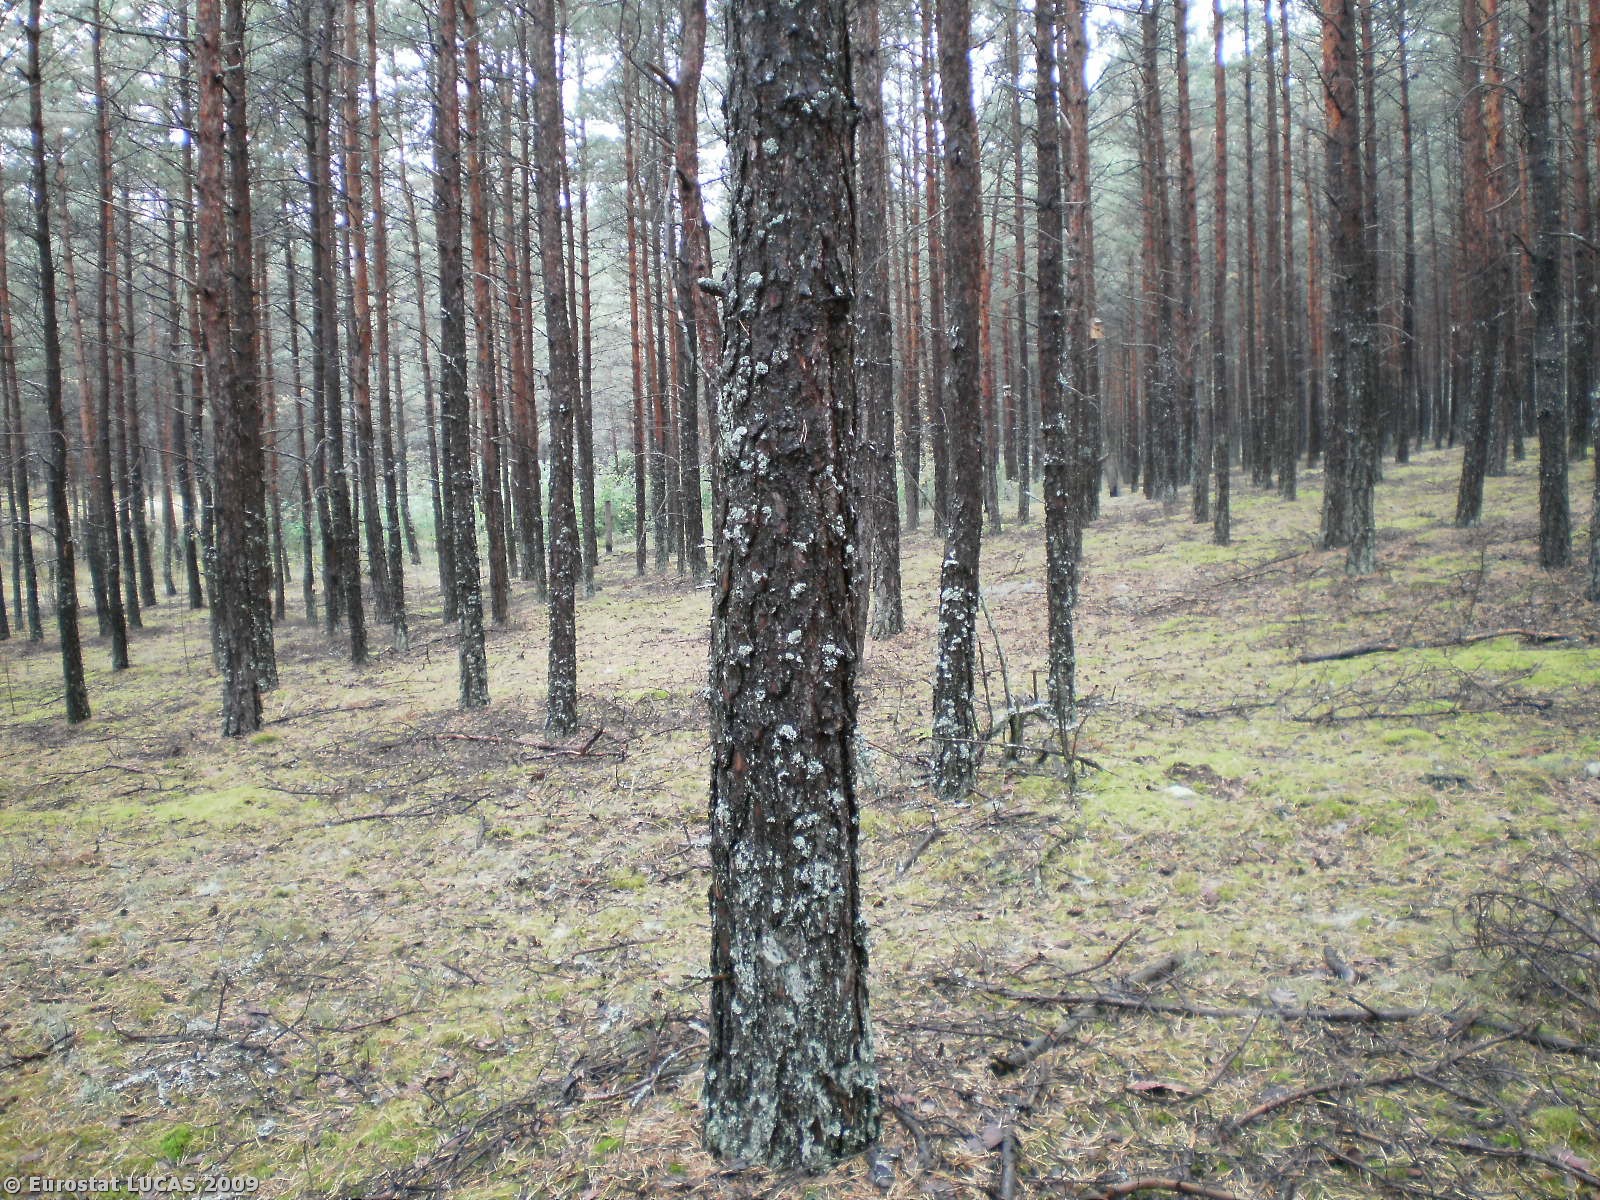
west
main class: Woodland
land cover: Coniferous woodland
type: hemiboreal forest and nemoral coniferous forest and mixed broadleaved-coniferous forest
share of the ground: > 75 %
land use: Forestry
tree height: > 5 m
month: September
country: PL
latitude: 53.8341
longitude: 17.8389
